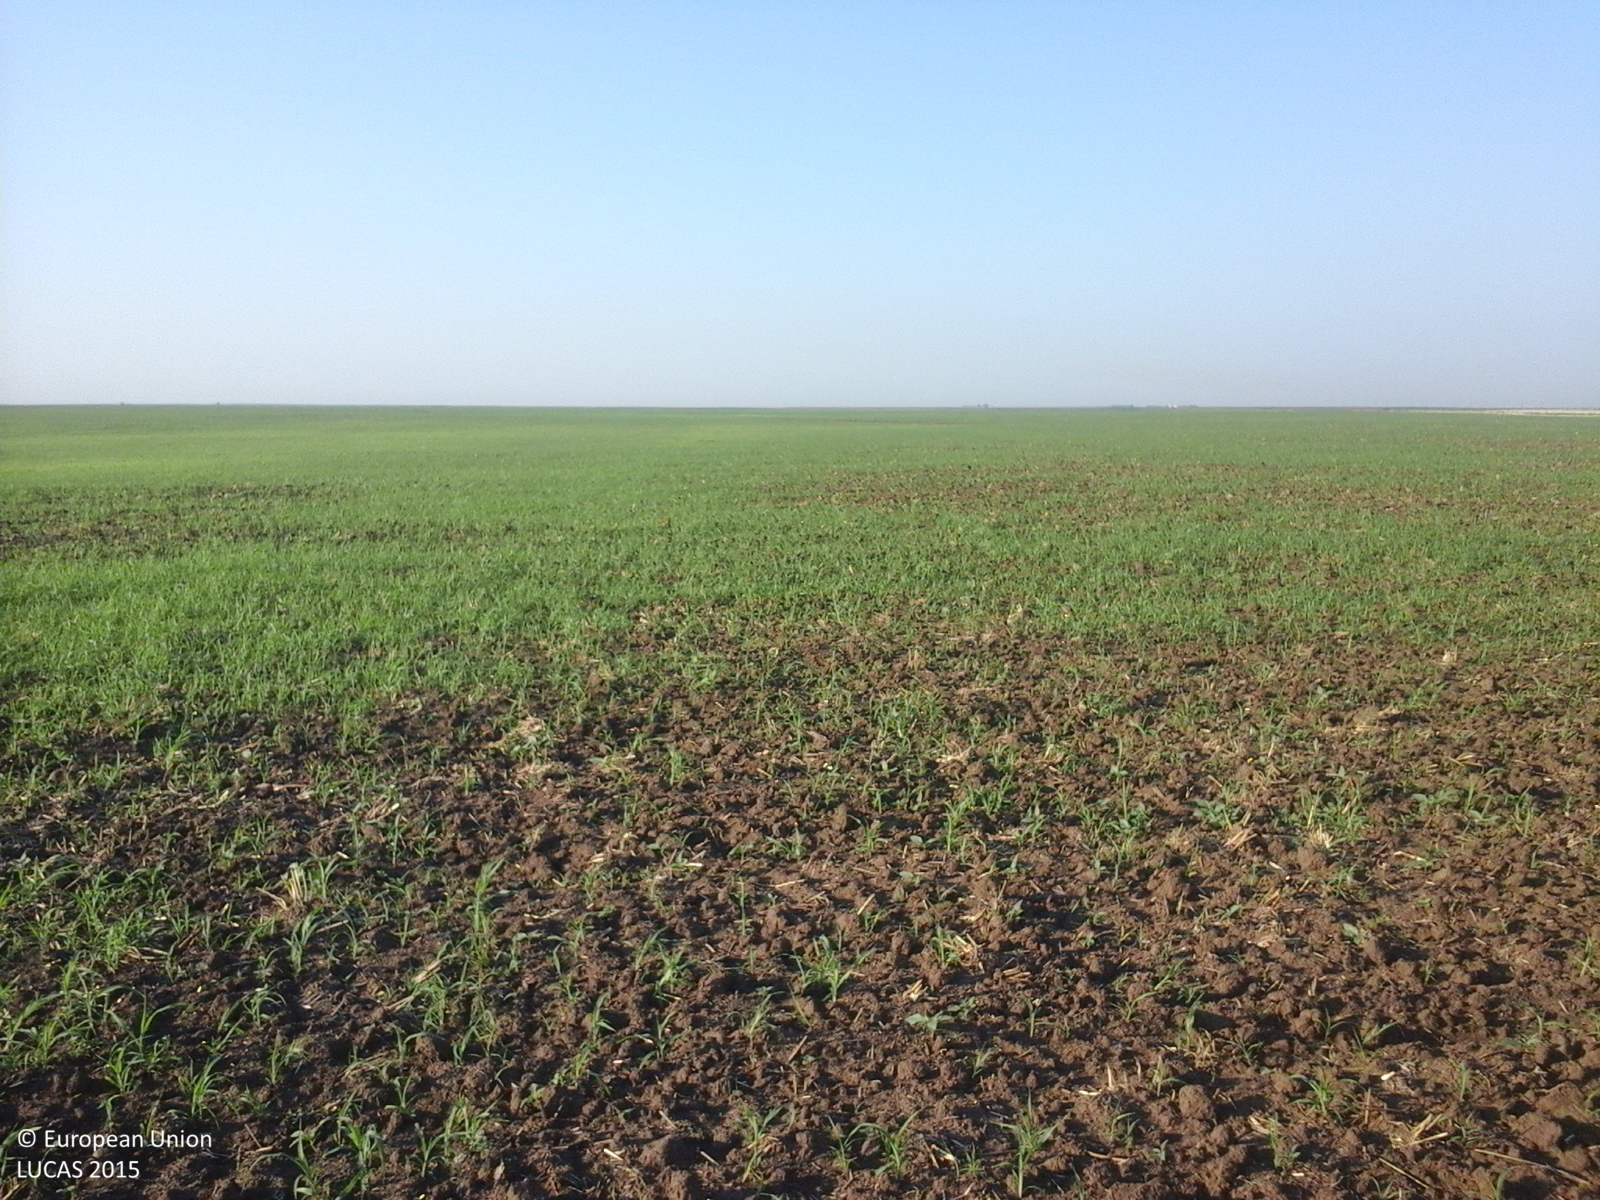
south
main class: Cropland
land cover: Common wheat
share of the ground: 25 - 50 %
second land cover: Spontaneously vegetated surfaces
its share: 10 - 25 %
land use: Agriculture (excluding fallow land and kitchen gardens)
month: July
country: RO
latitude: 44.3909
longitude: 27.4258
